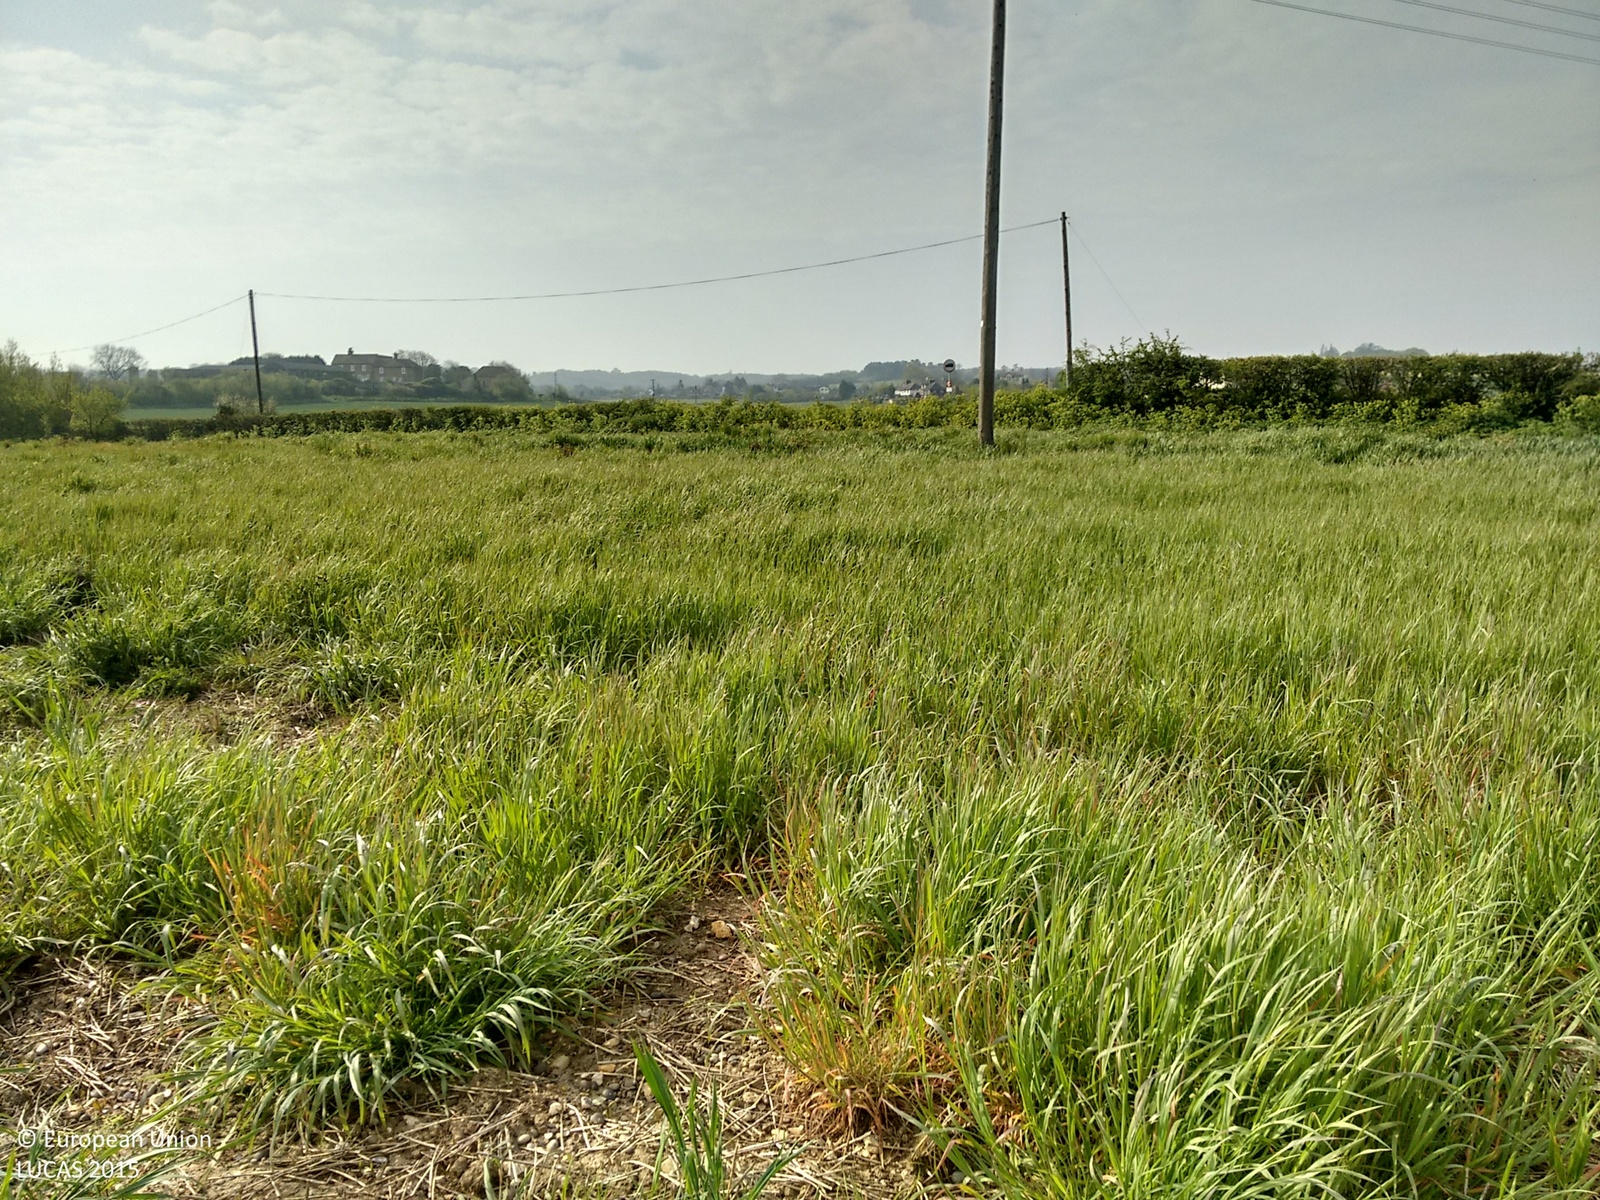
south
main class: Grassland
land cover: Spontaneously vegetated surfaces
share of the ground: 50 - 75 %
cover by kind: herbaceous plants 50 %, unconsolidated bare surface 50 %
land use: Fallow land
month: April
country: GB
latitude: 51.4292
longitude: 0.4355
